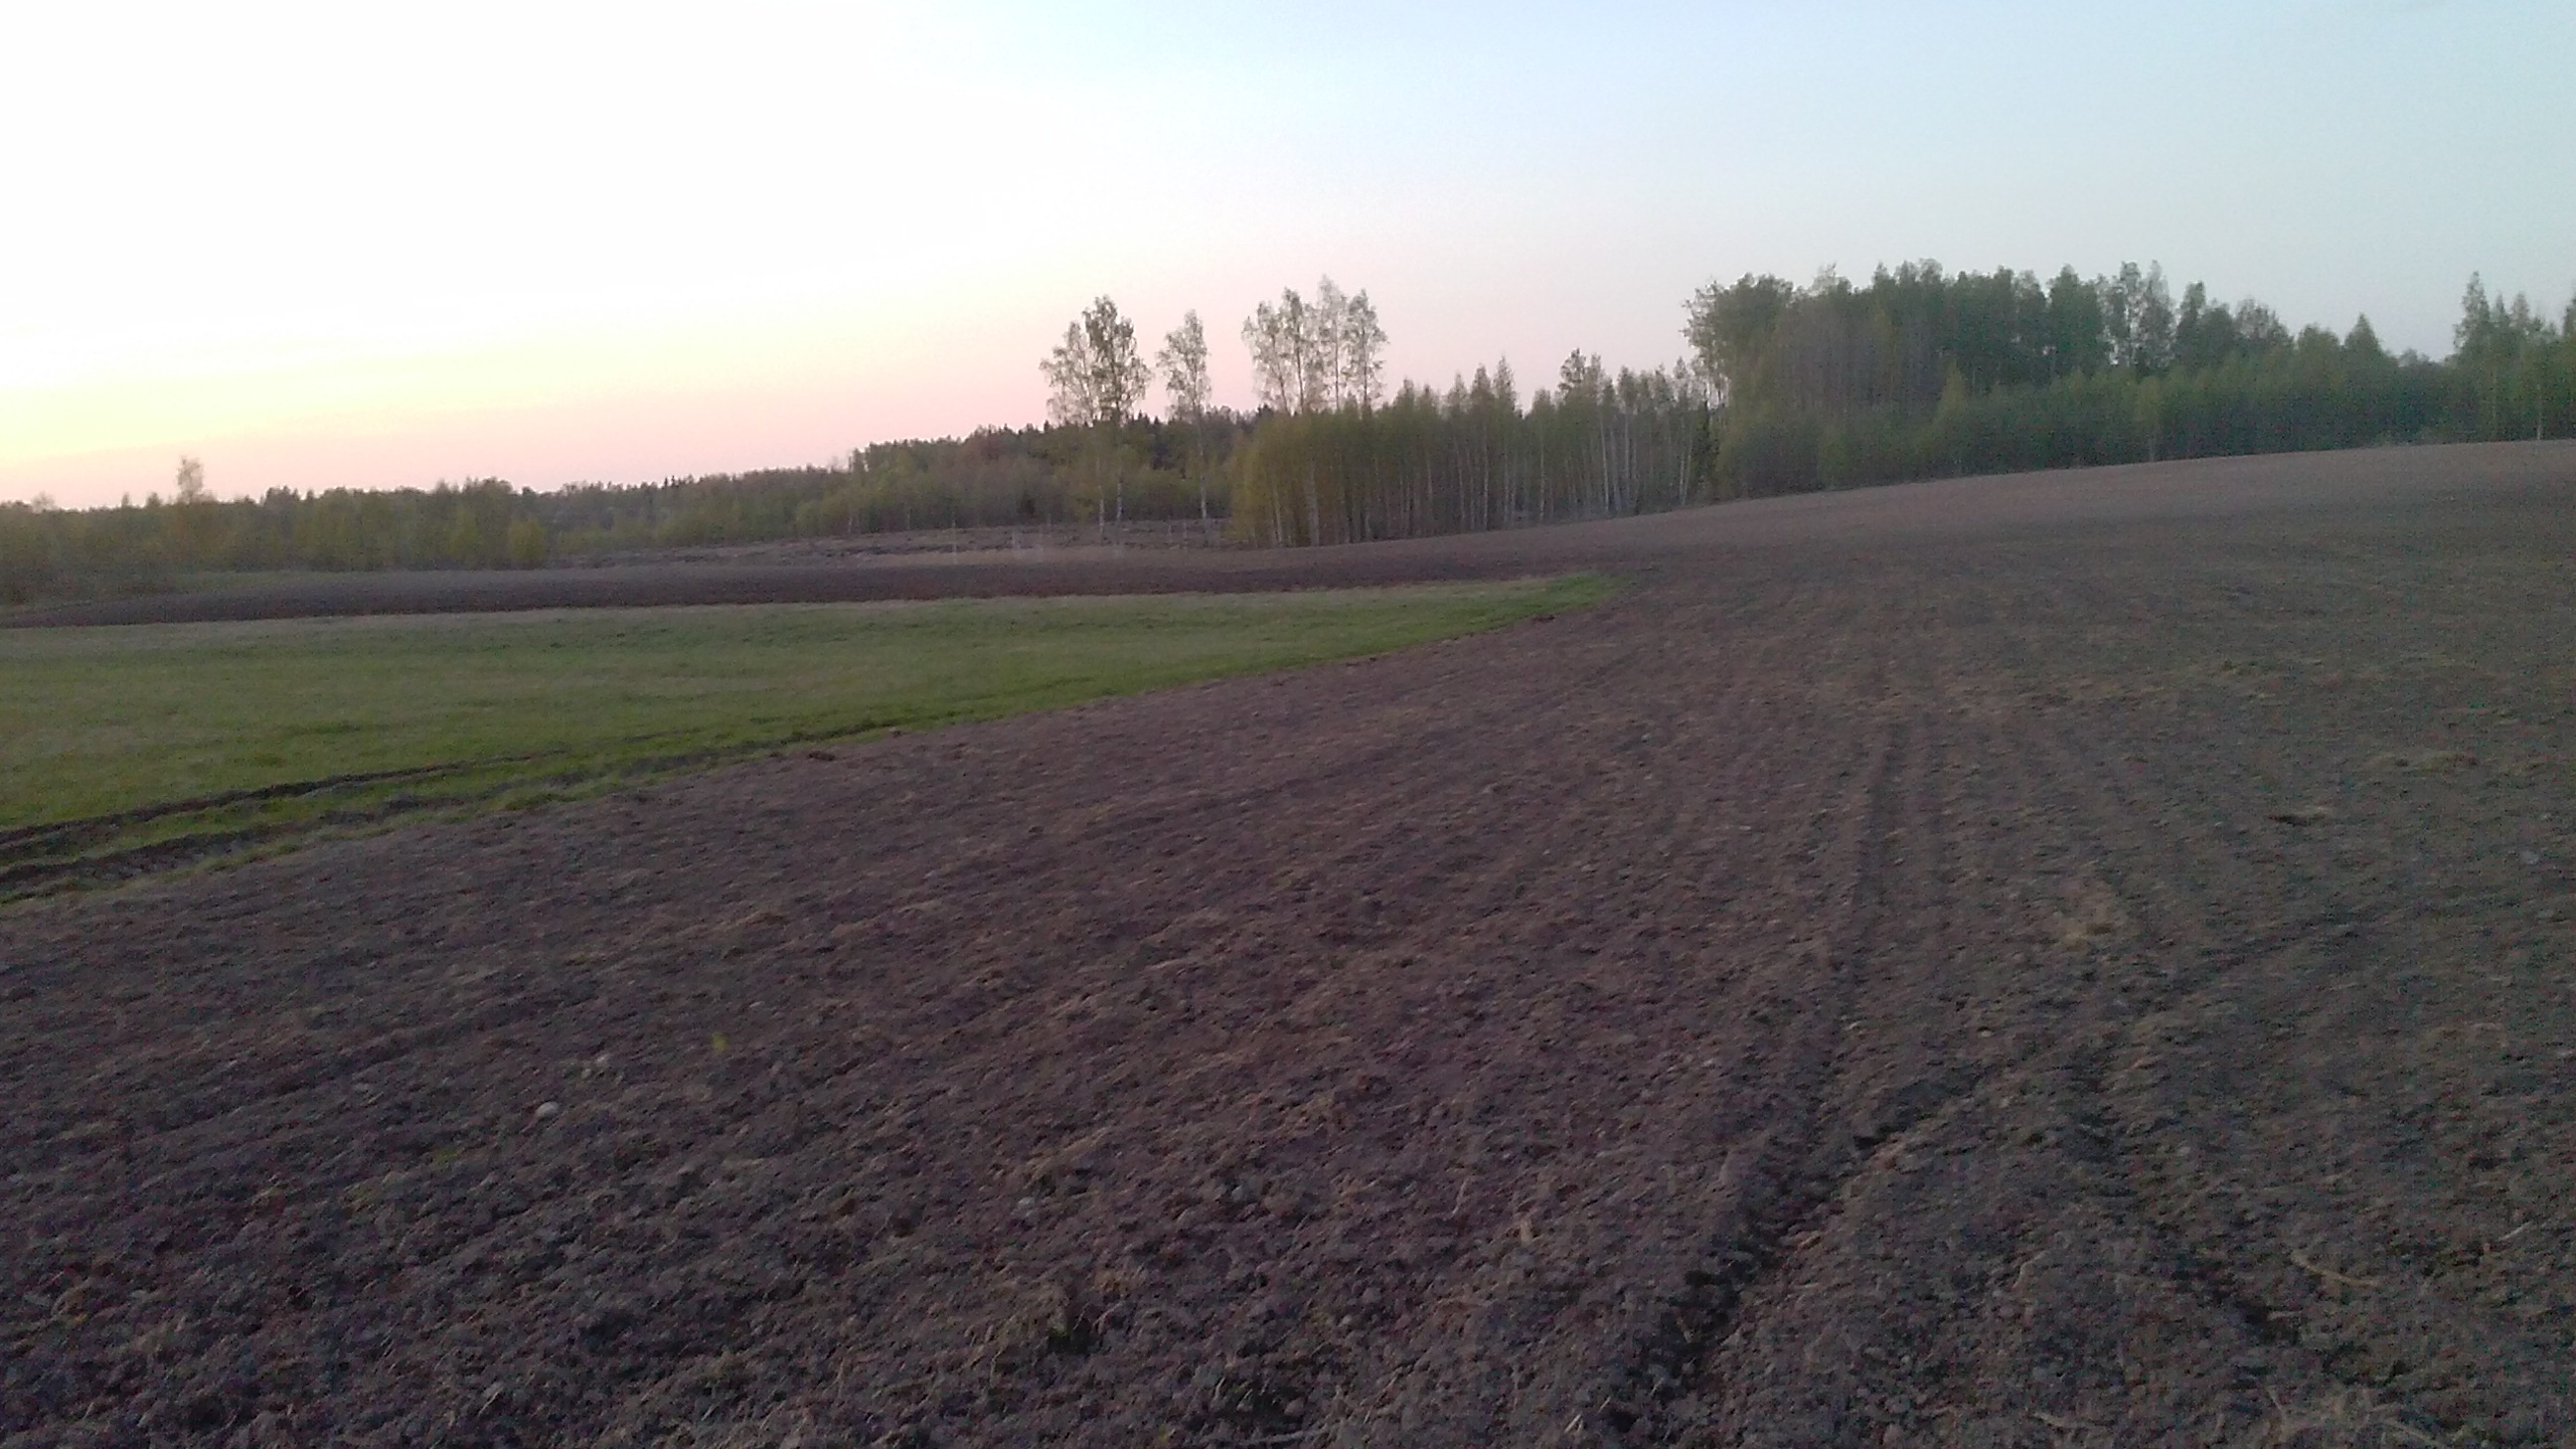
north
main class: Cropland
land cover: Oats
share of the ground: < 10 %
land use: Agriculture (excluding fallow land and kitchen gardens)
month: May
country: LV
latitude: 55.9366
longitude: 27.5860
